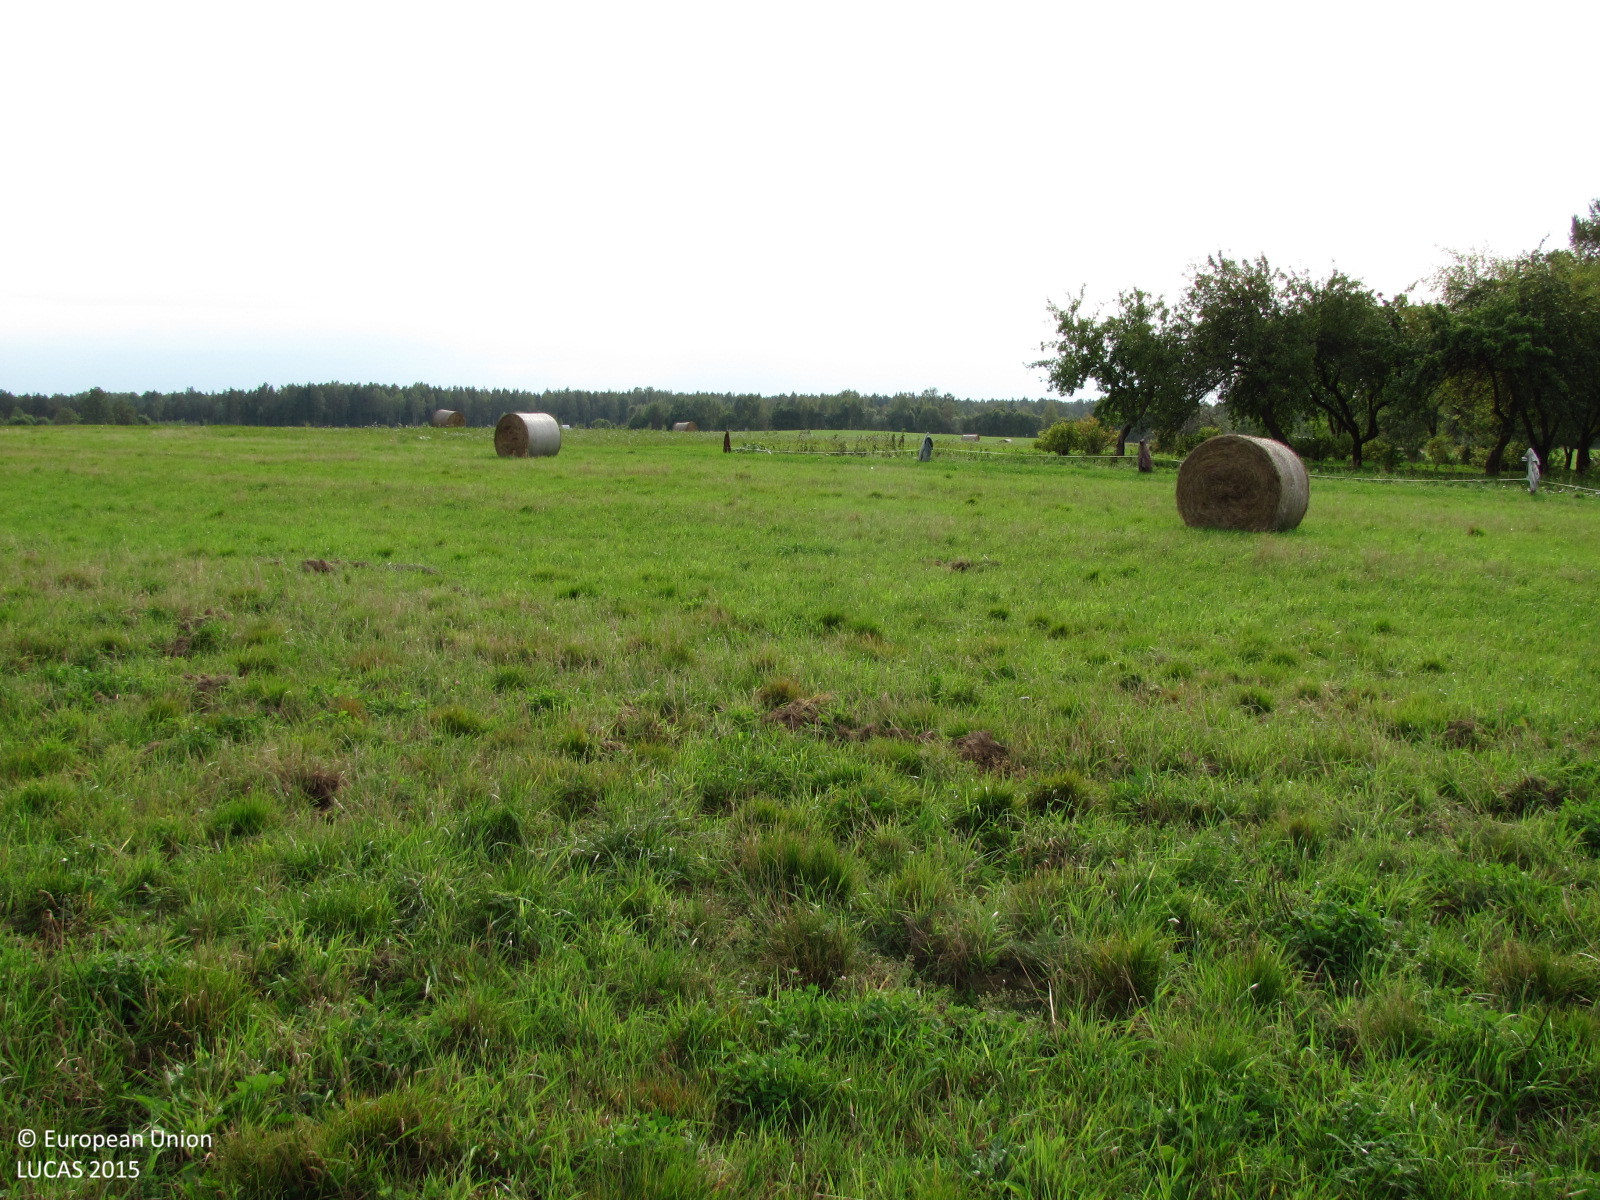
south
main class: Grassland
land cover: Grassland without tree/shrub cover
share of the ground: > 75 %
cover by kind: herbaceous plants 100 %
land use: Agriculture (excluding fallow land and kitchen gardens)
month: September
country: LV
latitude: 57.1600
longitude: 24.5950
